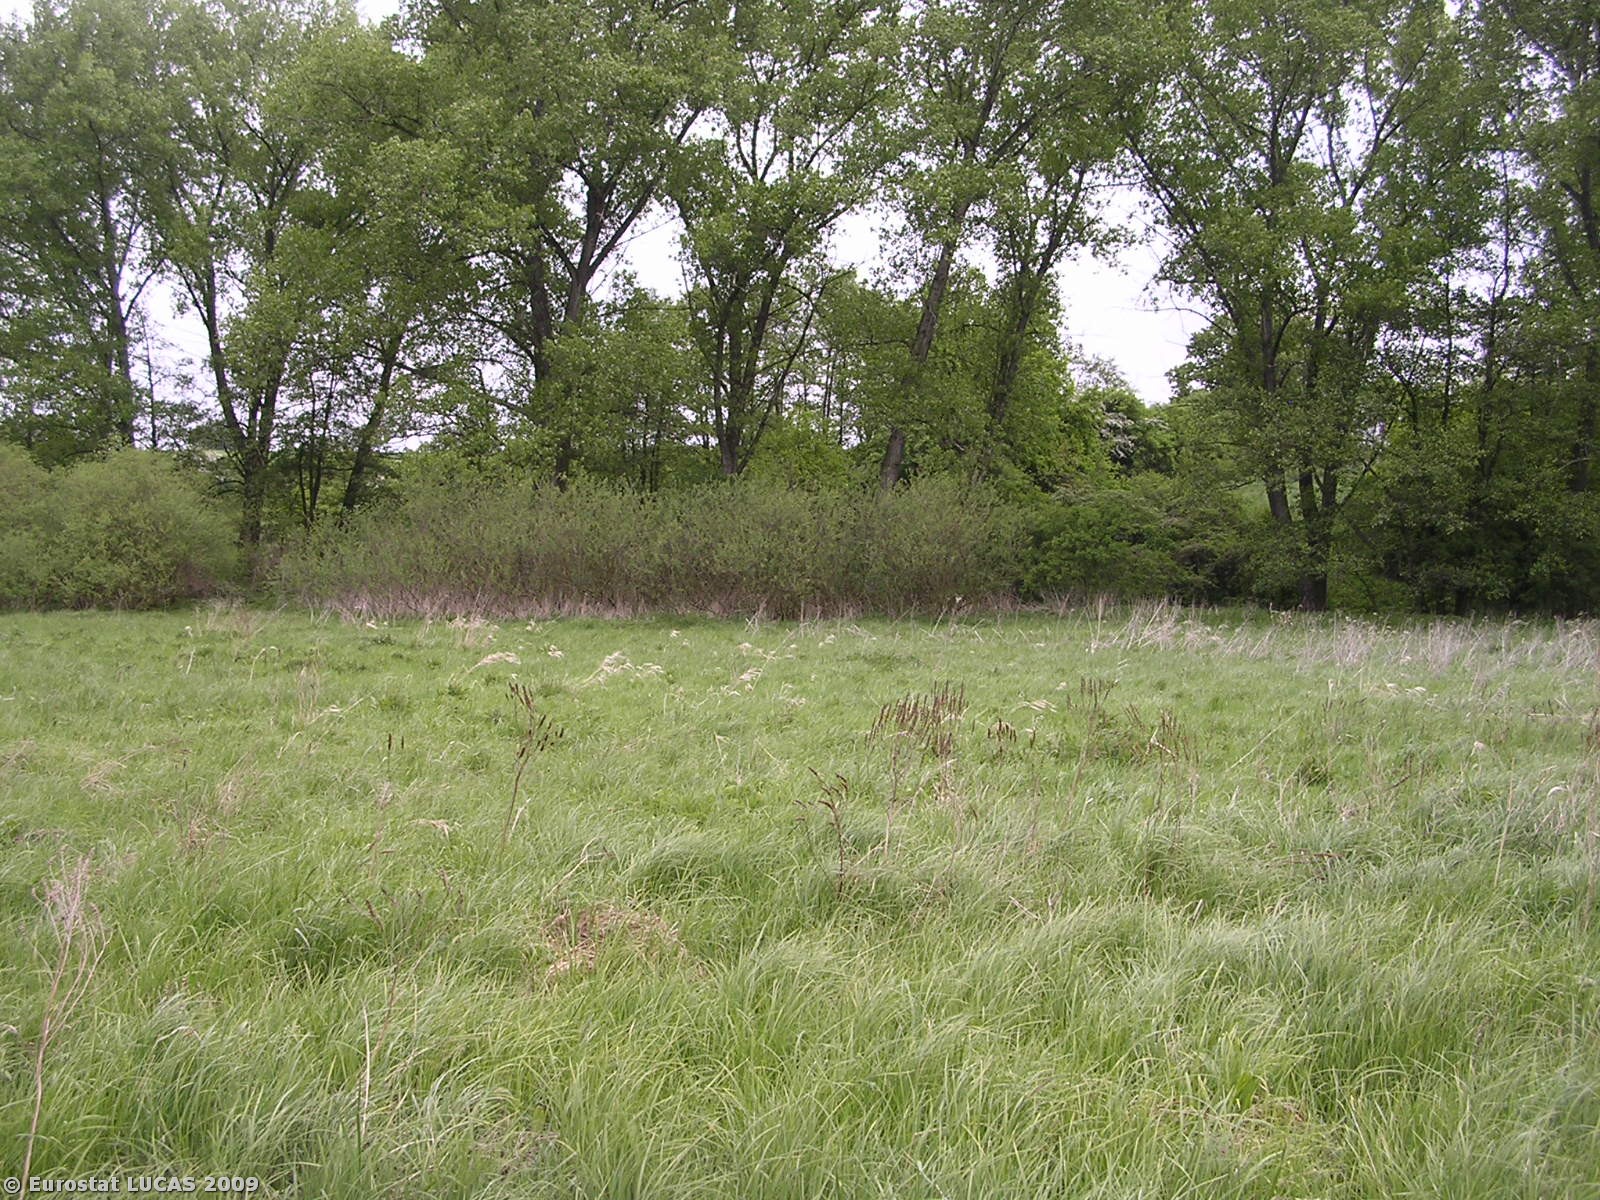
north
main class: Grassland
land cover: Grassland without tree/shrub cover
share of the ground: > 75 %
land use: Unused
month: May
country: CZ
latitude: 50.0197
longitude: 14.5937
